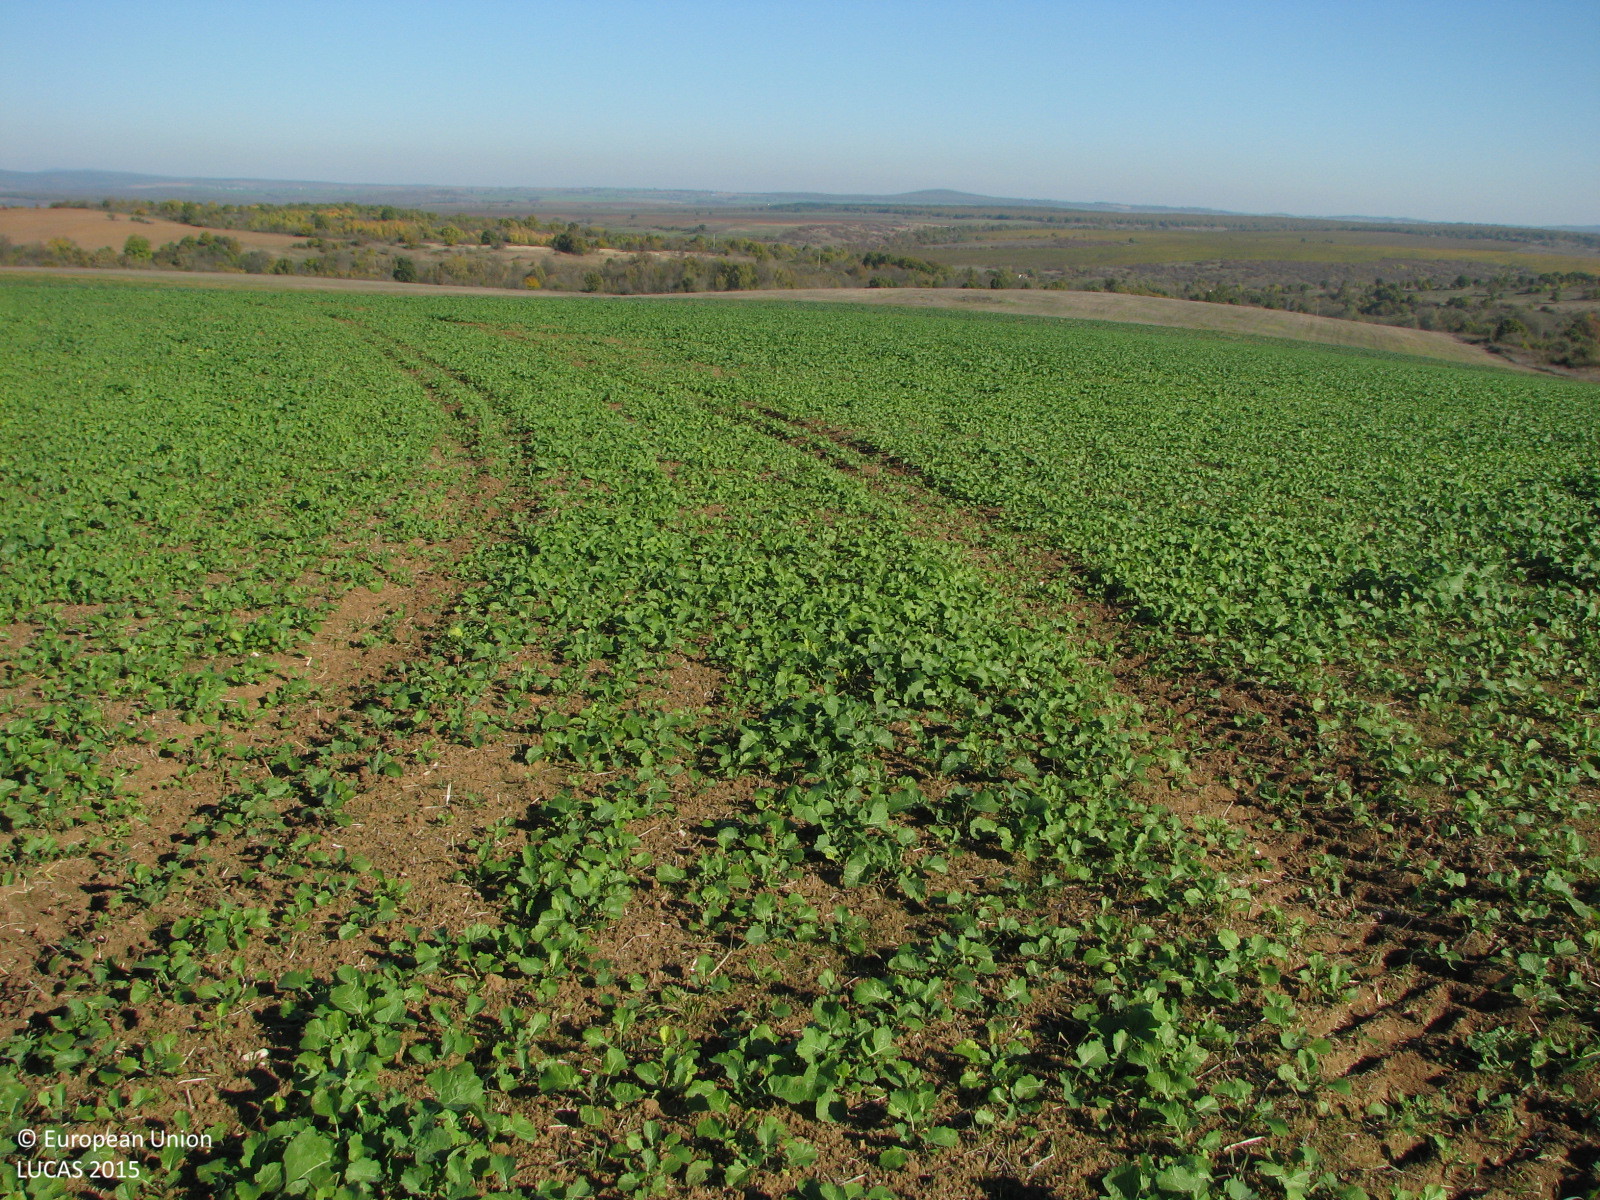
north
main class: Cropland
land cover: Rape and turnip rape
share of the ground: > 75 %
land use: Agriculture (excluding fallow land and kitchen gardens)
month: November
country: BG
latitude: 42.1186
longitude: 26.8228
